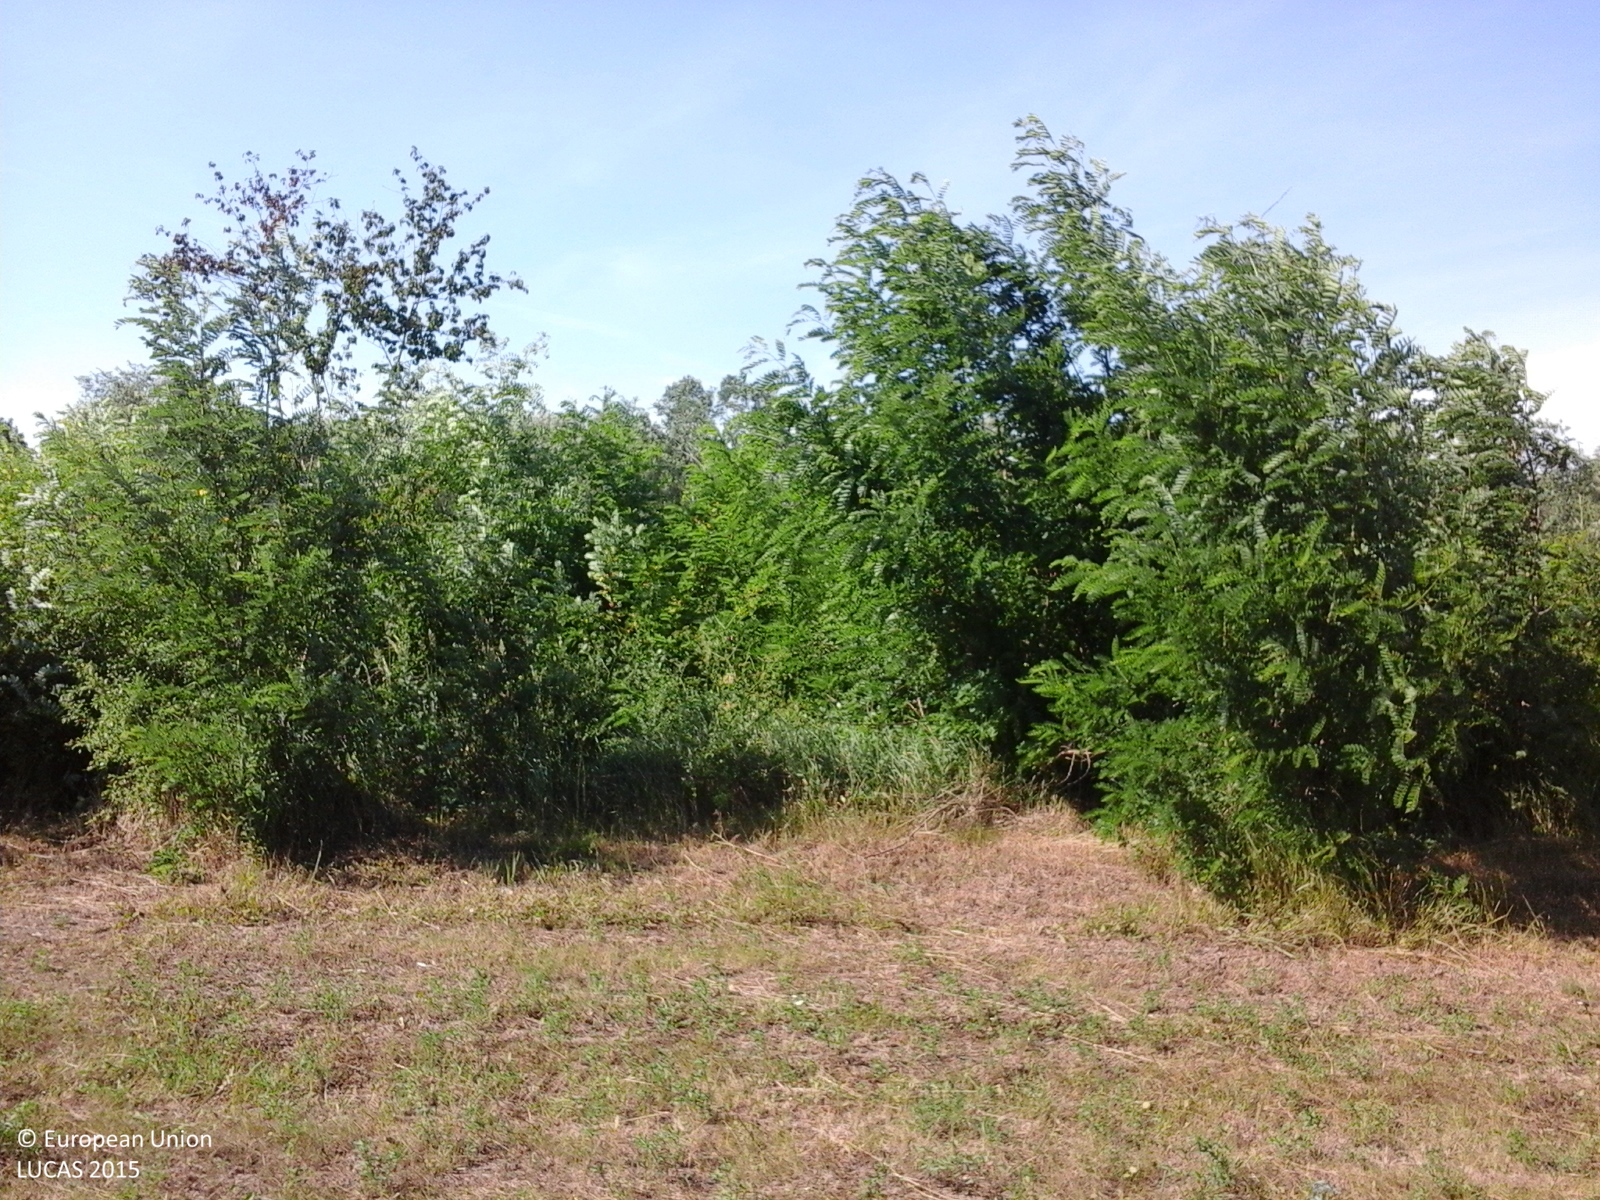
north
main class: Cropland
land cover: Other leguminous and mixtures for fodder
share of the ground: 25 - 50 %
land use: Agriculture (excluding fallow land and kitchen gardens)
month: June
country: RO
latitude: 48.2471
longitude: 26.7871
